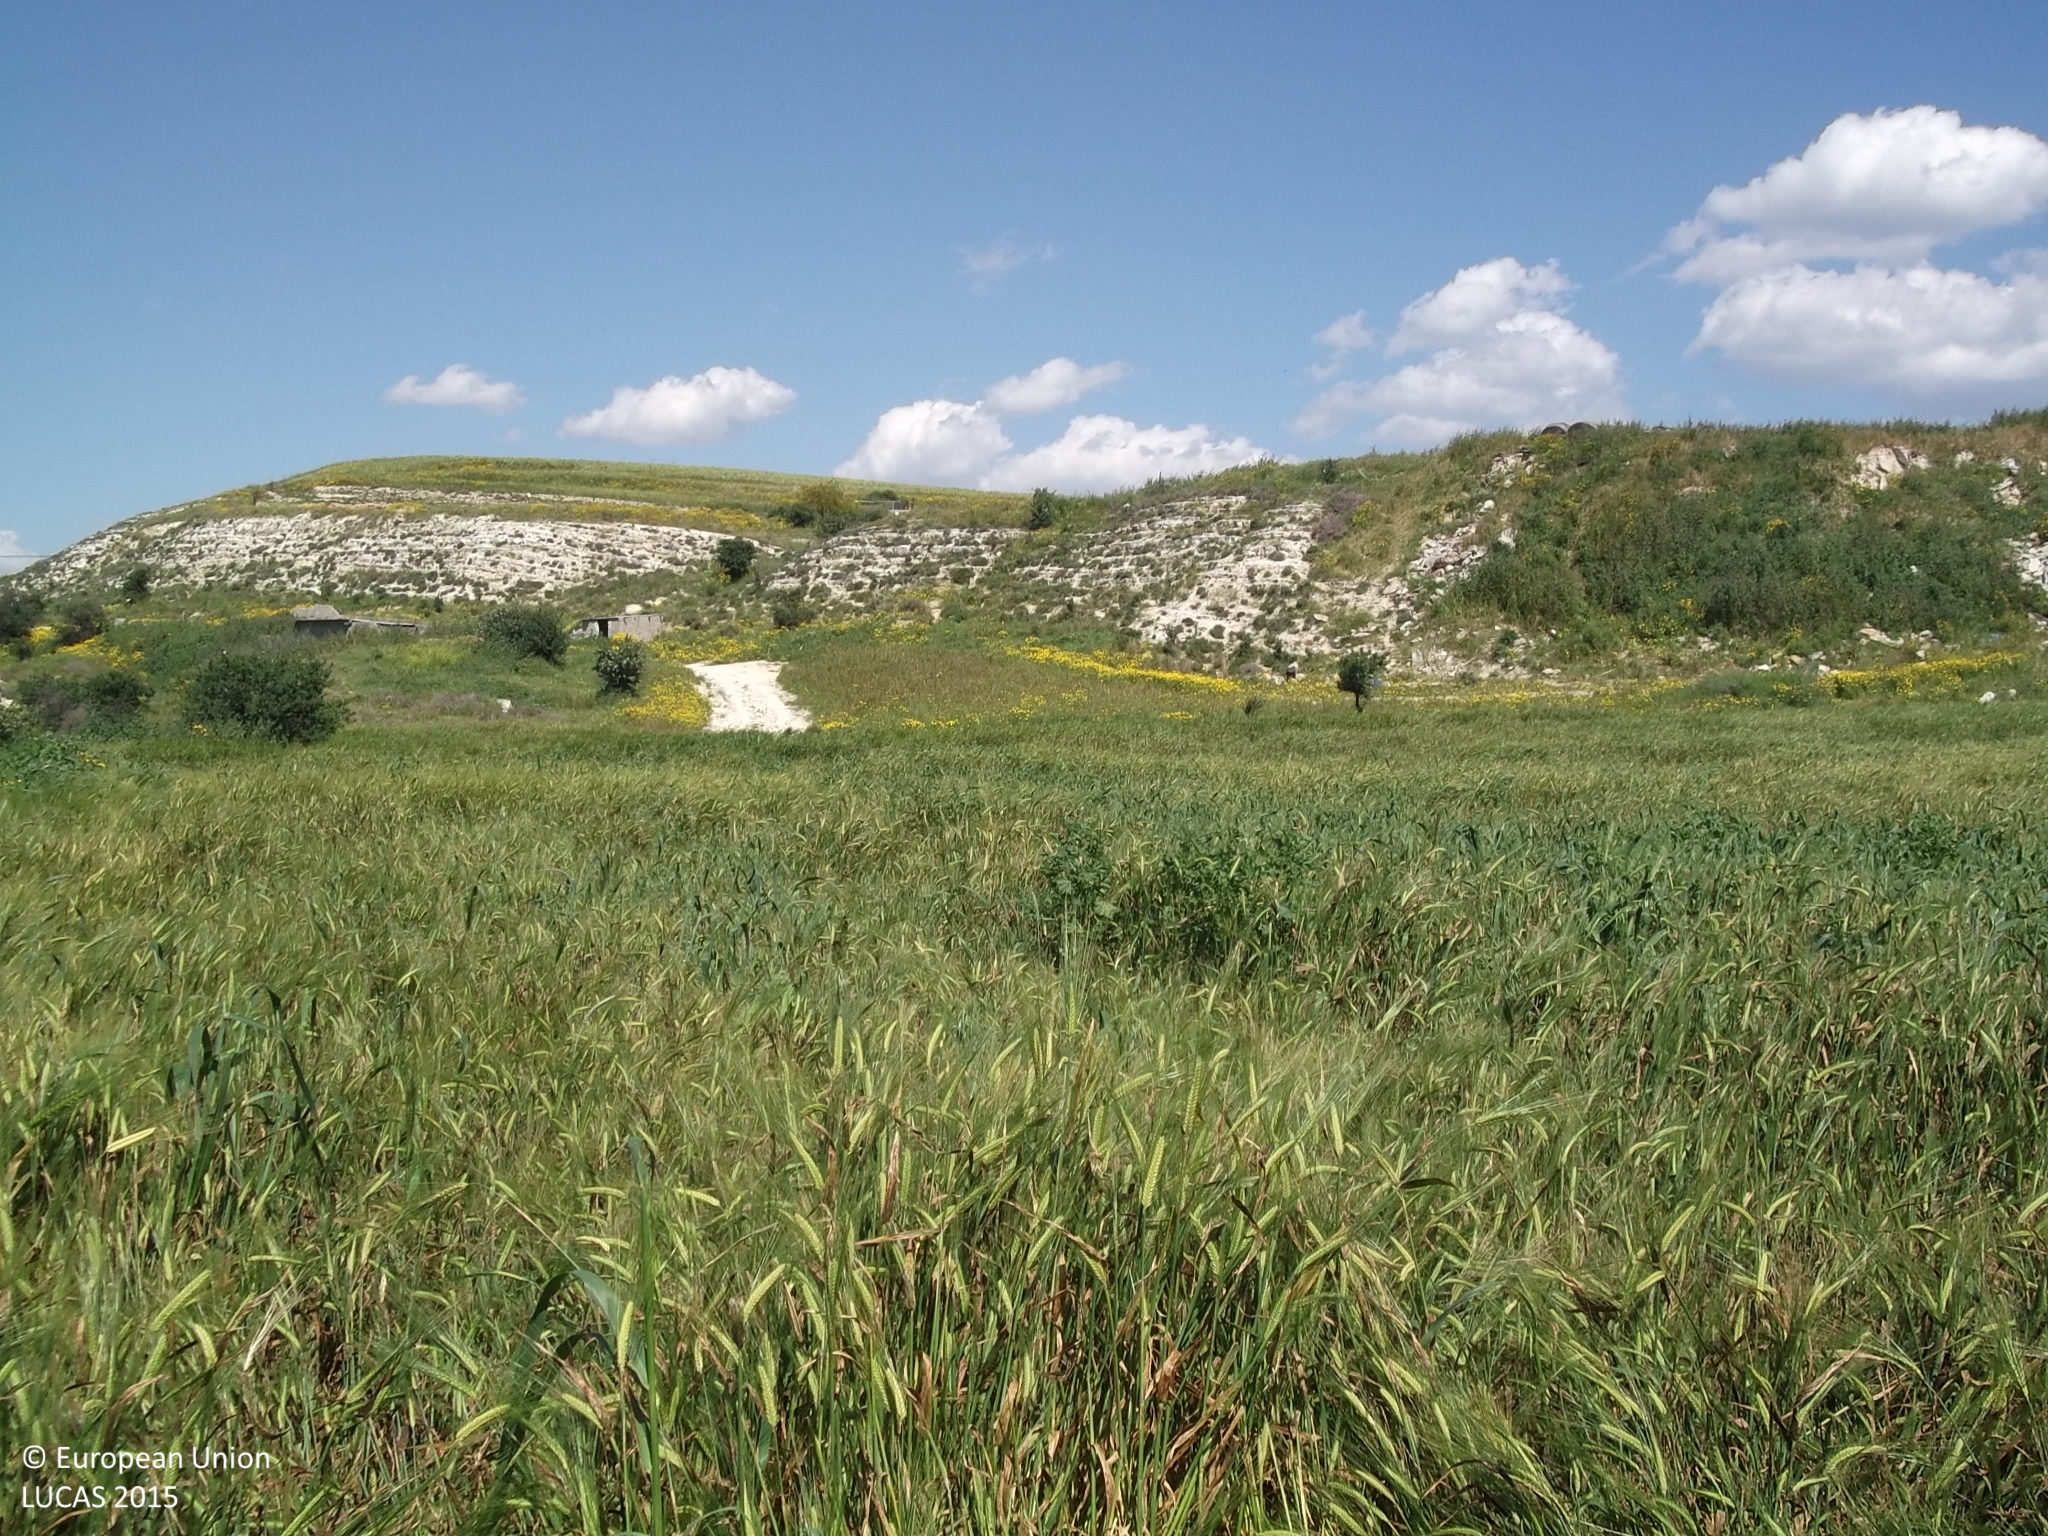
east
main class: Cropland
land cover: Mixed cereals for fodder
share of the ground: > 75 %
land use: Agriculture (excluding fallow land and kitchen gardens)
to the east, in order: Mixed cereals for fodder; Barley; Paved roads, cycling and walking lanes; Electric lines; Grassland without tree/shrub cover; Paved roads, cycling and walking lanes; Grassland without tree/shrub cover; Common wheat; Shrubland without tree cover
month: April
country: CY
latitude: 34.9170
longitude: 33.5399
